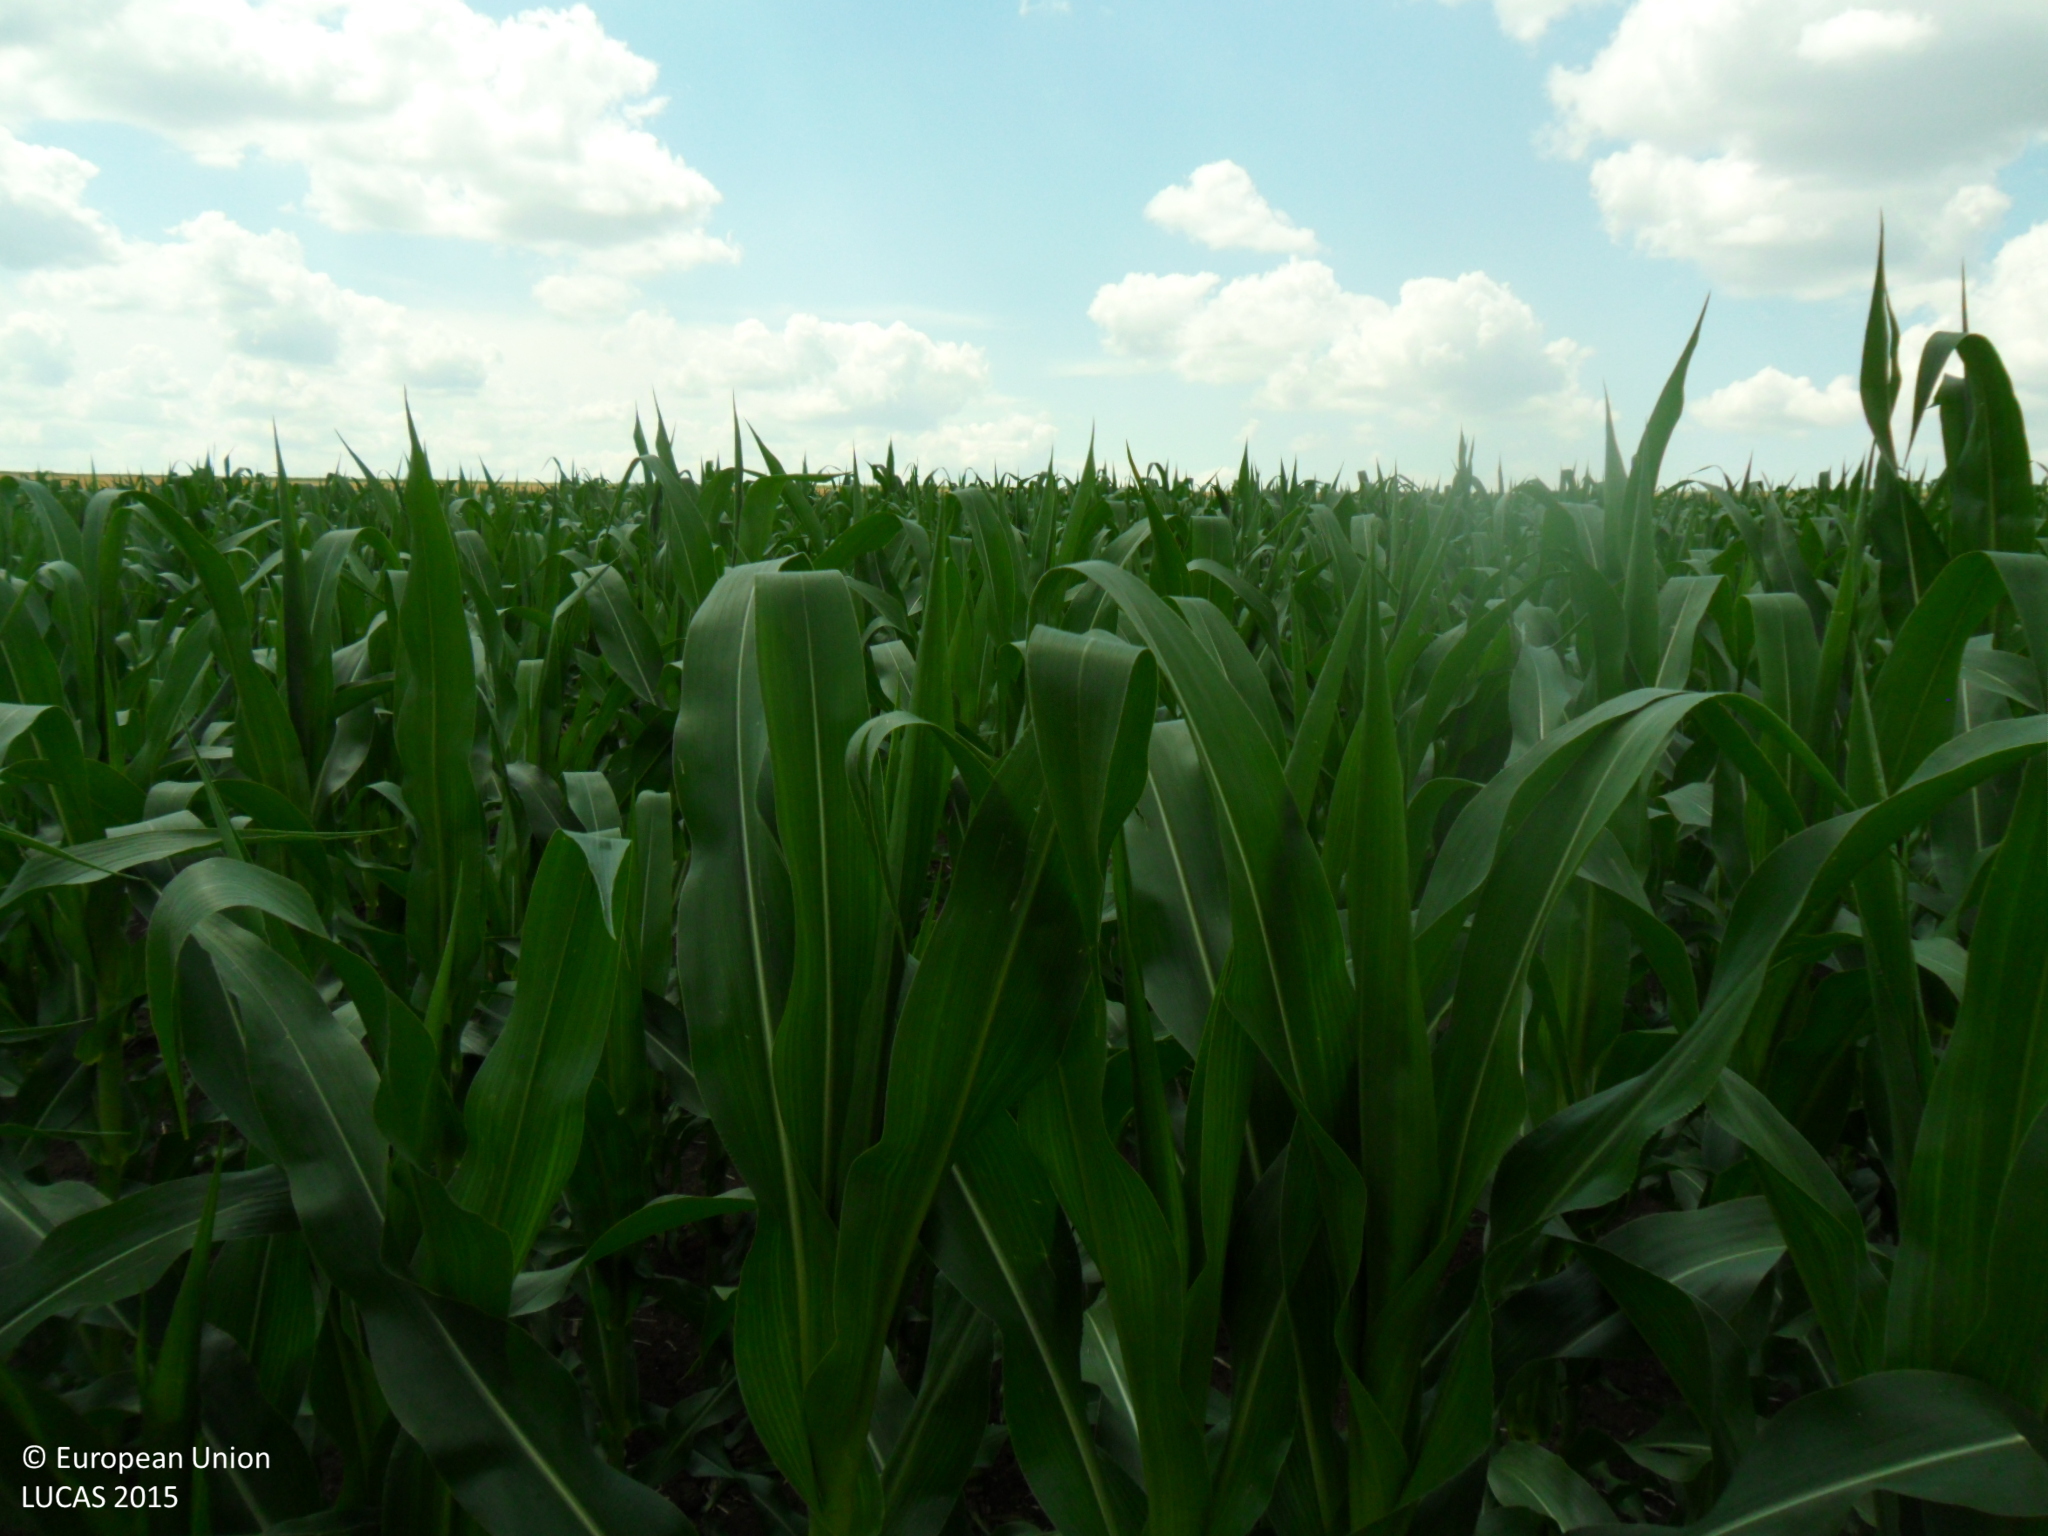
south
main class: Cropland
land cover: Maize
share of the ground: > 75 %
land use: Agriculture (excluding fallow land and kitchen gardens)
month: June
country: BG
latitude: 43.3491
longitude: 27.0555
